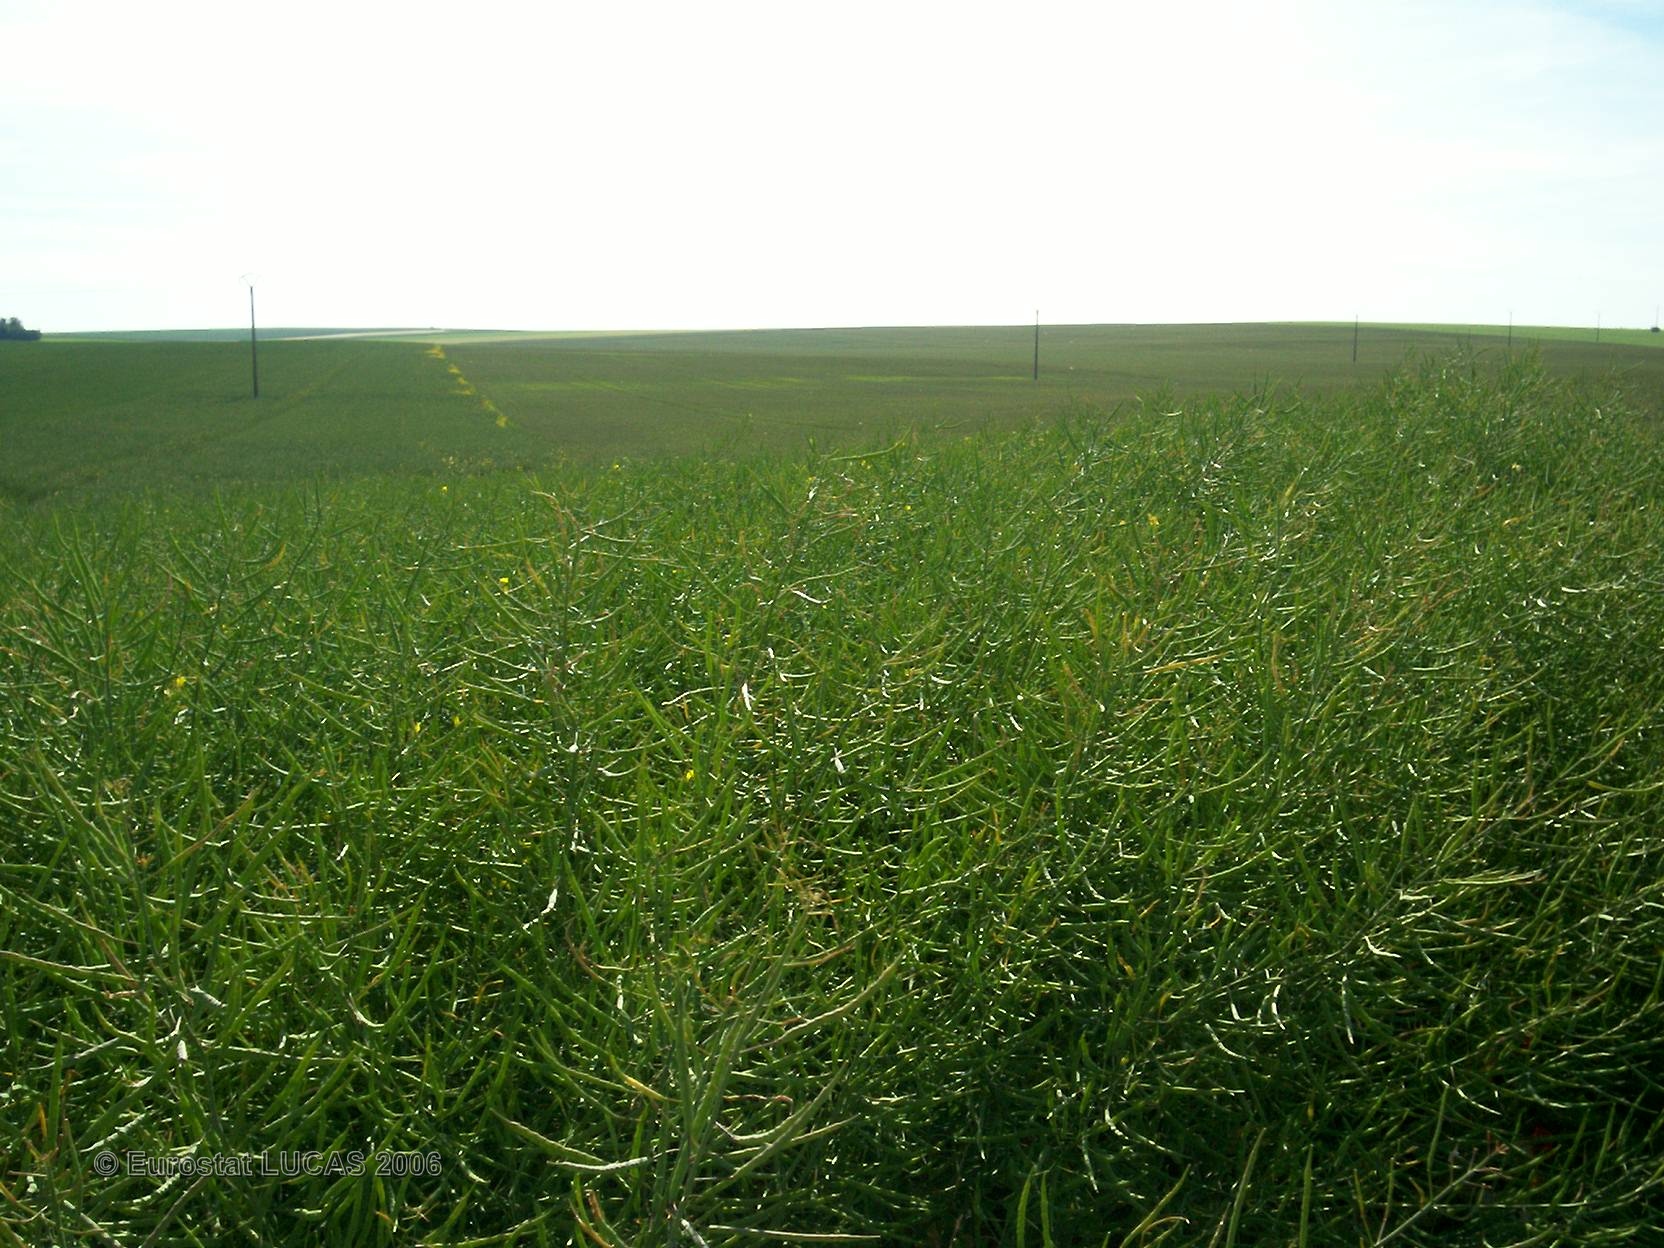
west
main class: Cropland
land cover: Rape and turnip rape
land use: Agriculture (excluding fallow land and kitchen gardens)
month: June
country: FR
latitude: 48.9748
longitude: 4.6005
